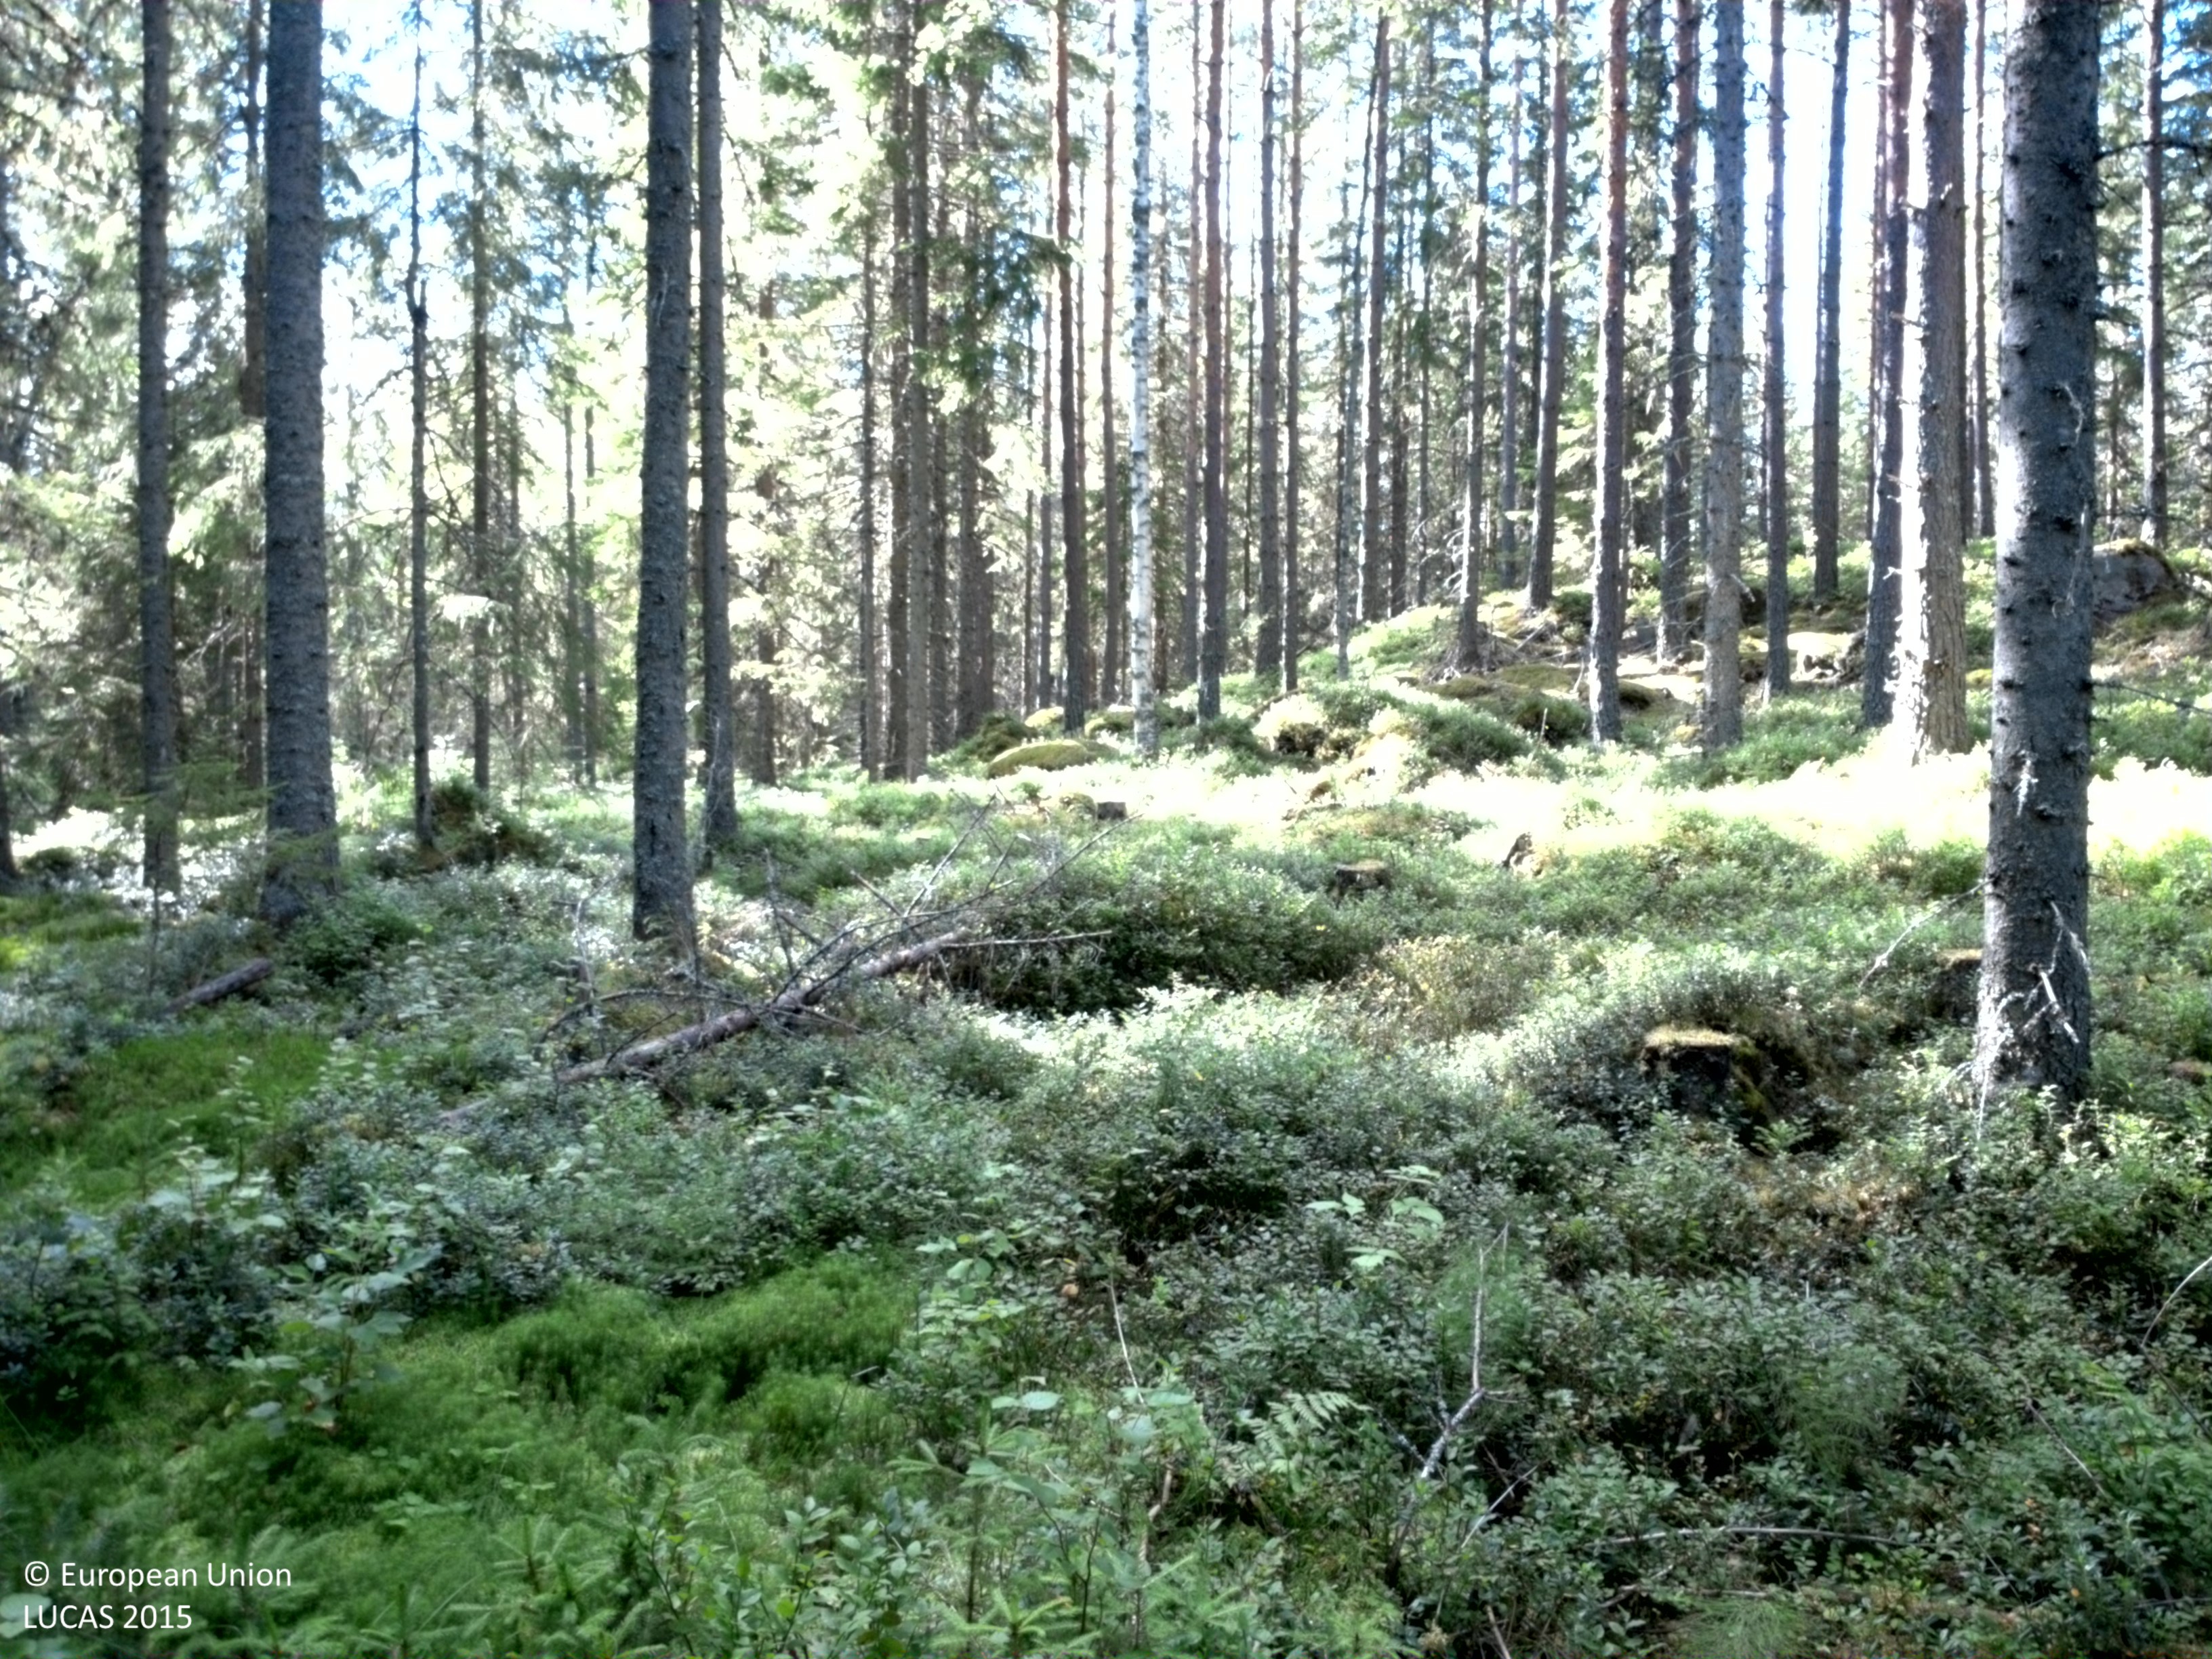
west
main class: Woodland
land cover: Spruce dominated coniferous woodland
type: boreal forest
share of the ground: 50 - 75 %
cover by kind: coniferous forest trees 65 %, shrubs 15 %, lichens and mosses 10 %, broadleaved forest trees 5 %, herbaceous plants 5 %
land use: Forestry
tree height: > 5 m
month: August
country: SE
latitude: 60.2801
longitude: 13.5525
